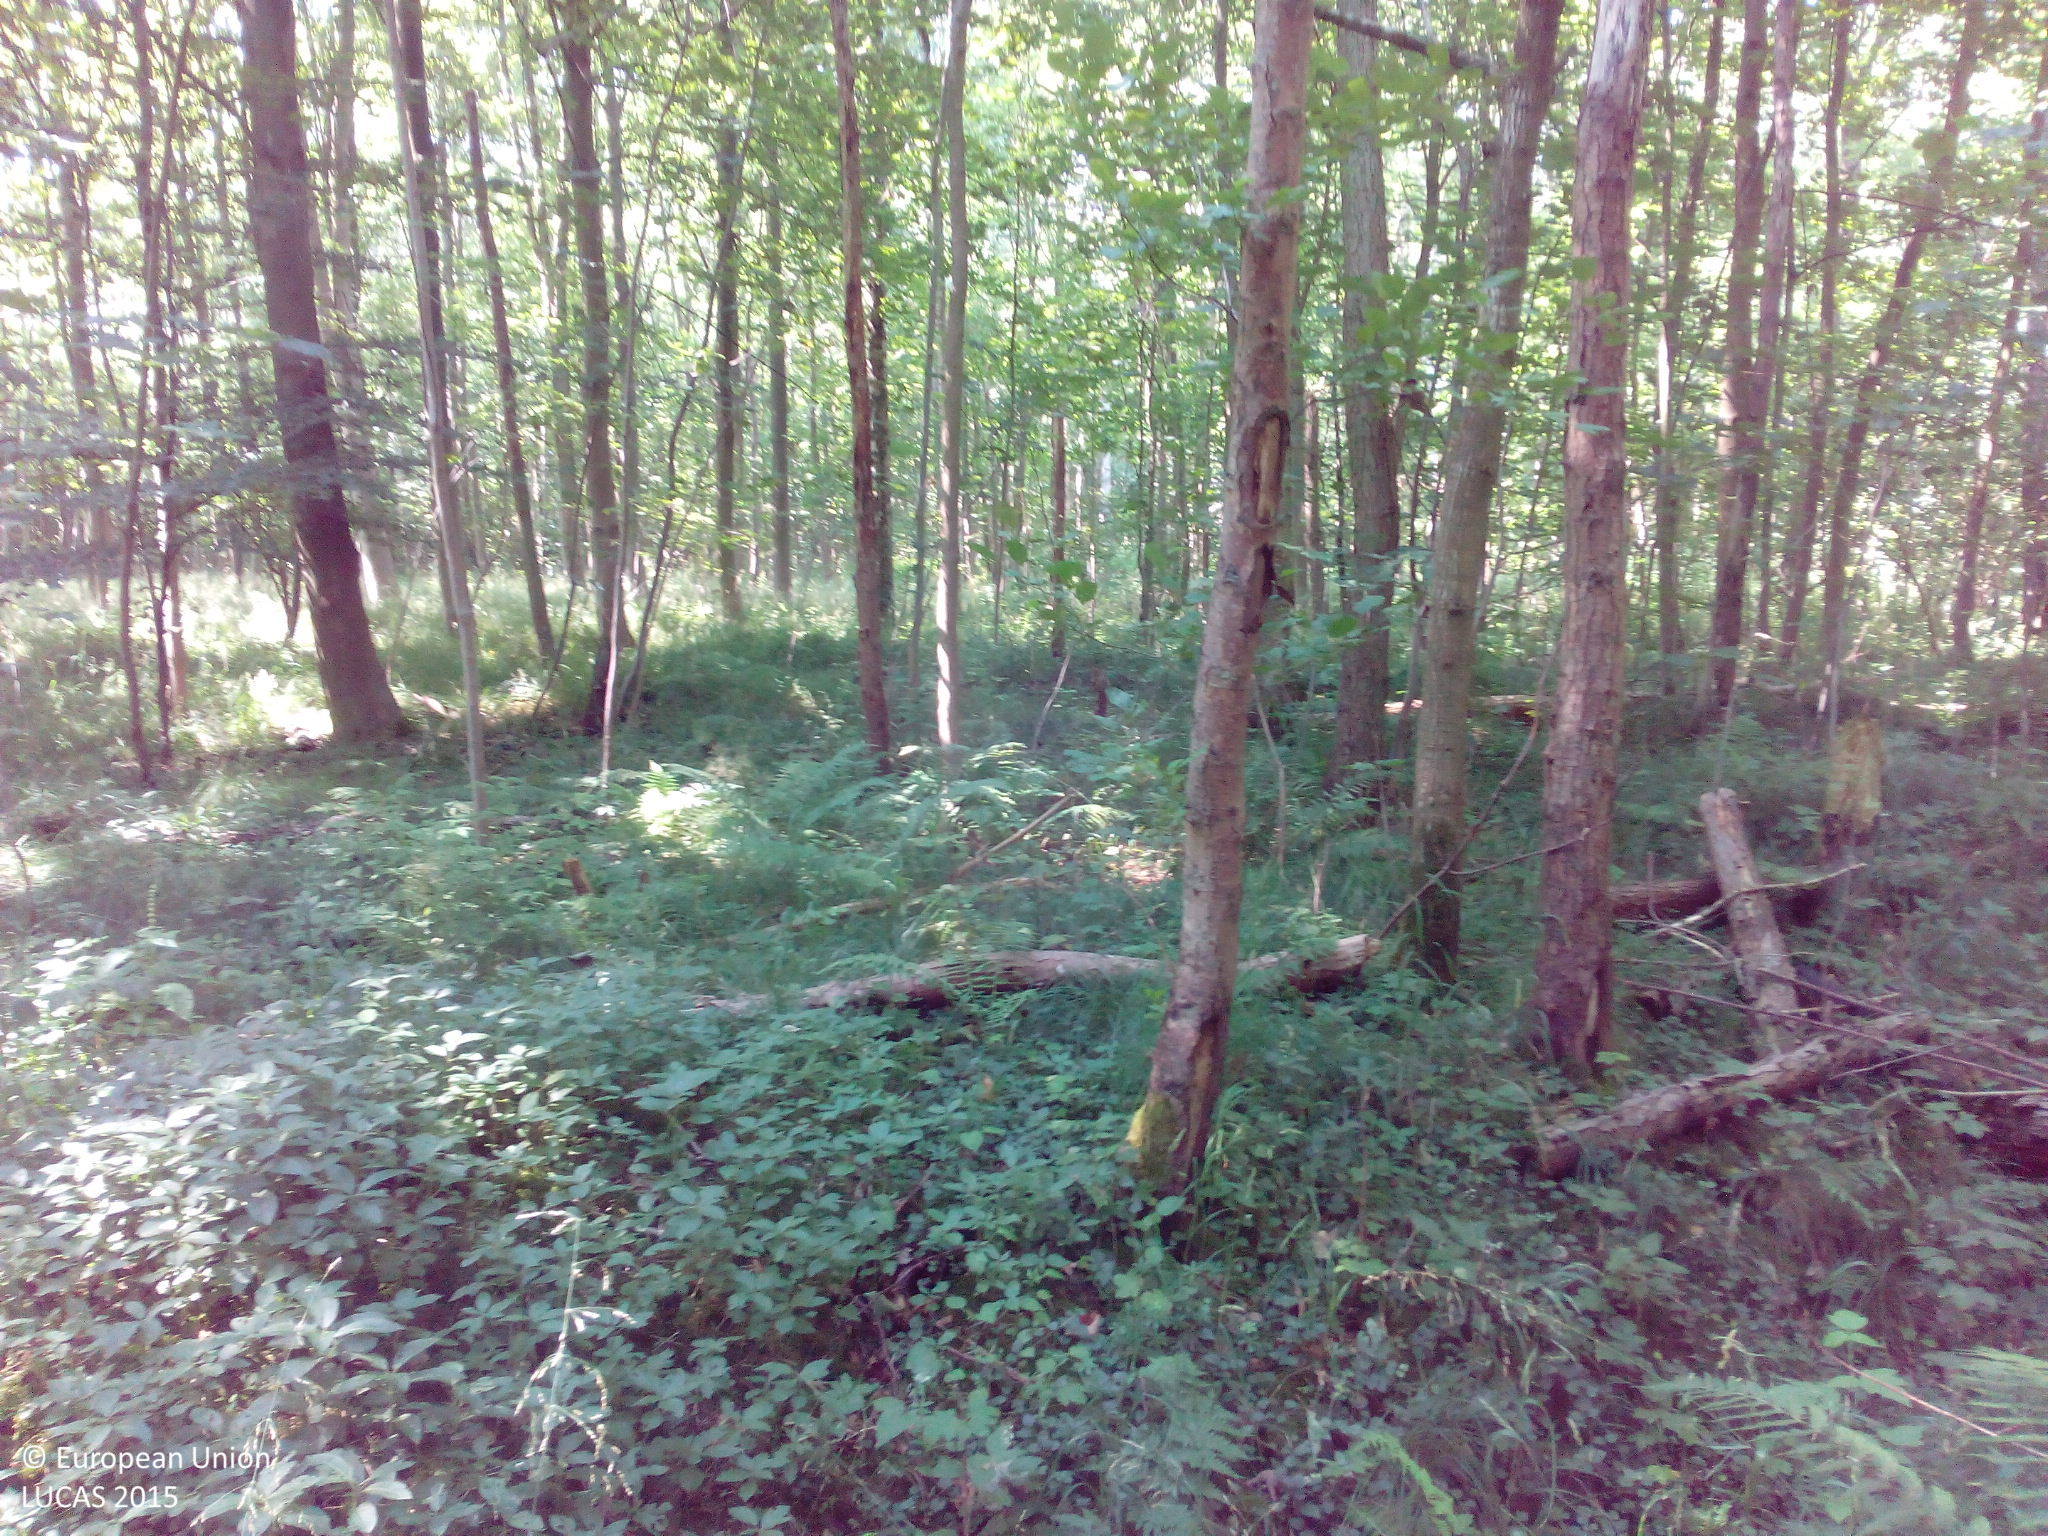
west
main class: Woodland
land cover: Broadleaved woodland
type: beech forest
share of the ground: > 75 %
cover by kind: broadleaved forest trees 100 %
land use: Forestry
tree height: > 5 m
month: August
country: DK
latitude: 55.4508
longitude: 12.1328
